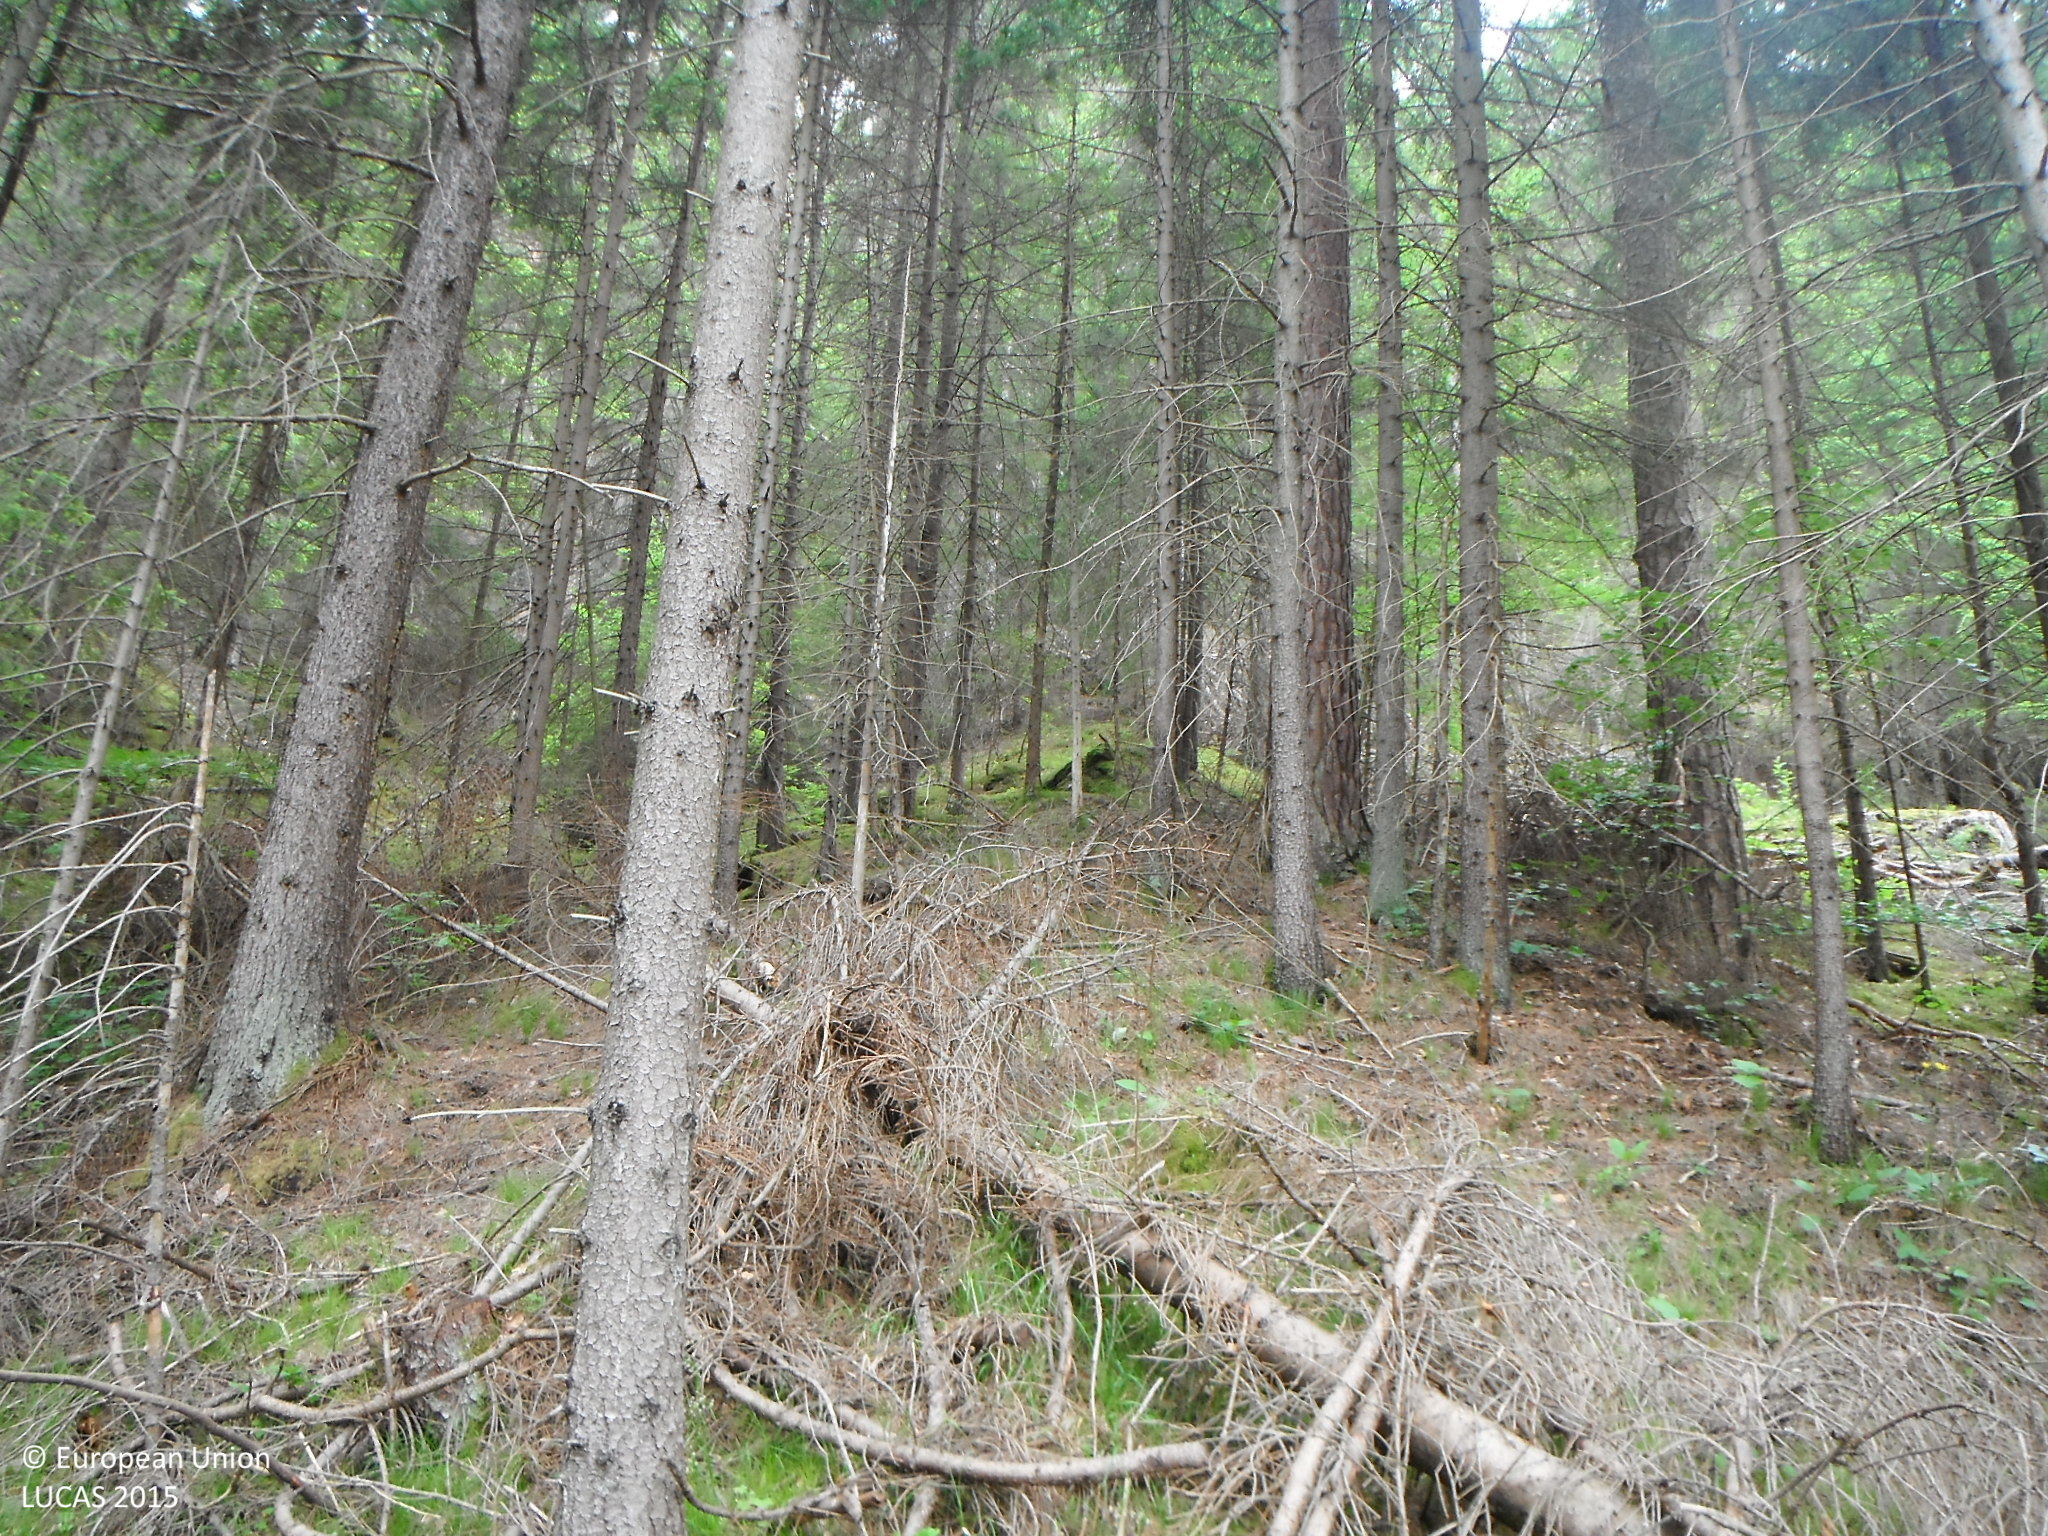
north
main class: Woodland
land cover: Spruce dominated coniferous woodland
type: alpine coniferous forest
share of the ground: > 75 %
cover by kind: coniferous forest trees 95 %, broadleaved forest trees 5 %
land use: Forestry
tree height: > 5 m
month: June
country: SK
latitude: 48.7810
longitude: 19.4013
